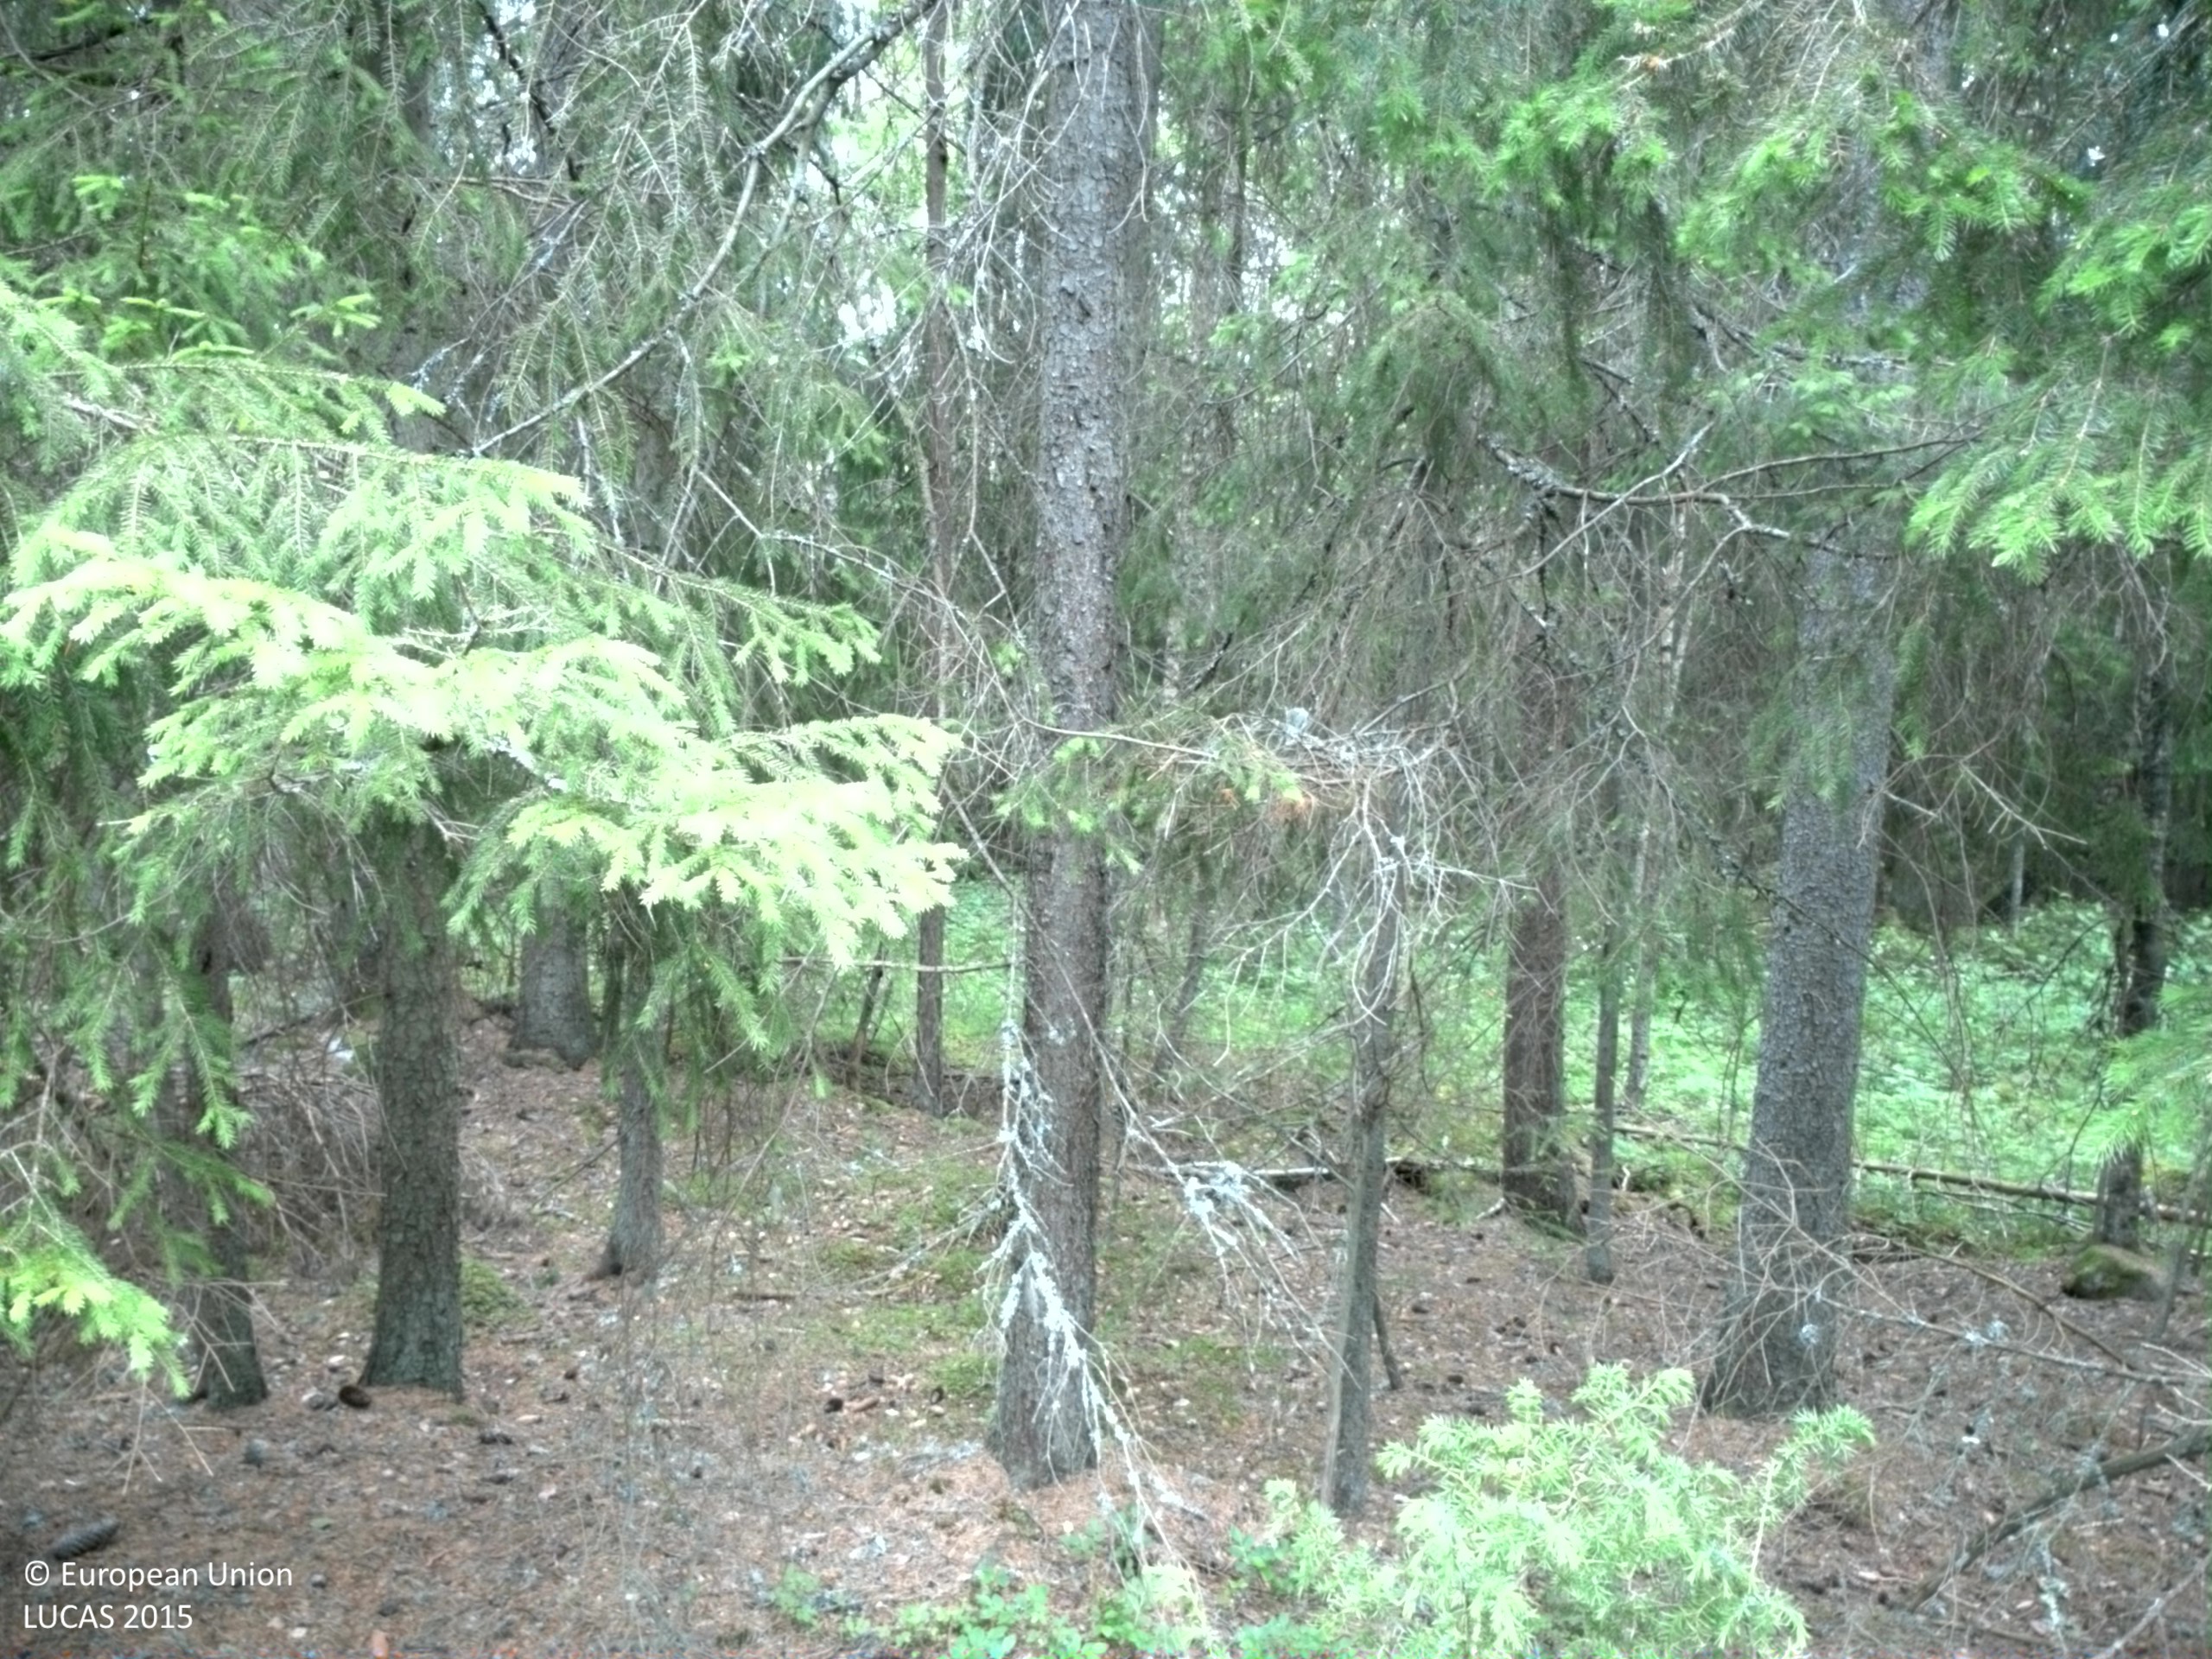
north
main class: Woodland
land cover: Spruce dominated coniferous woodland
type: boreal forest
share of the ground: > 75 %
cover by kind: coniferous forest trees 75 %, shrubs 15 %, lichens and mosses 5 %
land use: Forestry
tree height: > 5 m
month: June
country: SE
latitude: 60.1908
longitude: 17.2955
